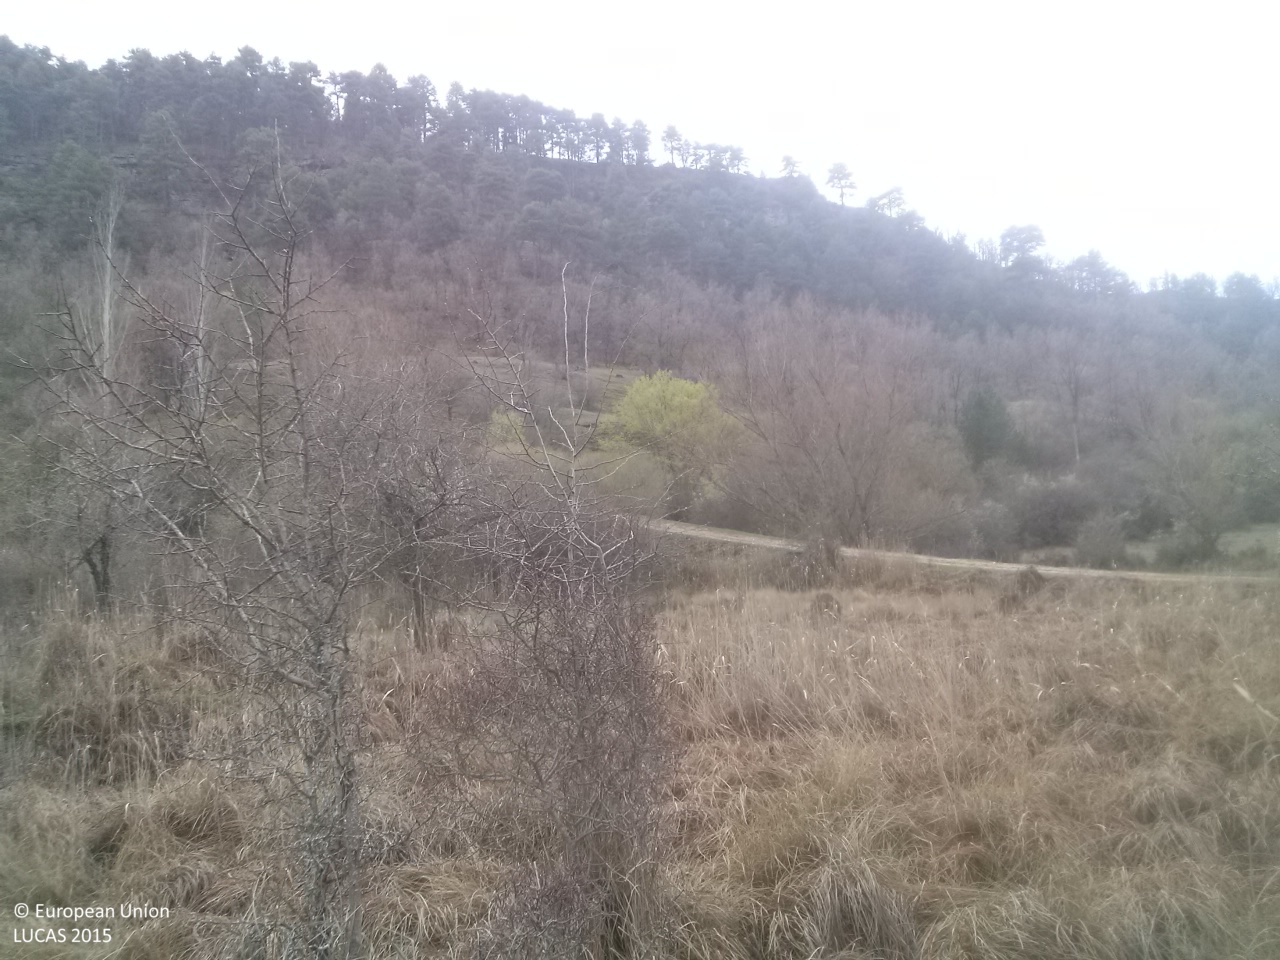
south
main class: Shrubland
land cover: Shrubland without tree cover
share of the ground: 25 - 50 %
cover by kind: herbaceous plants 65 %, shrubs 35 %
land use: Semi-natural and natural areas not in use
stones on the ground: < 10 %
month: April
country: ES
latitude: 40.2261
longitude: -1.9680
